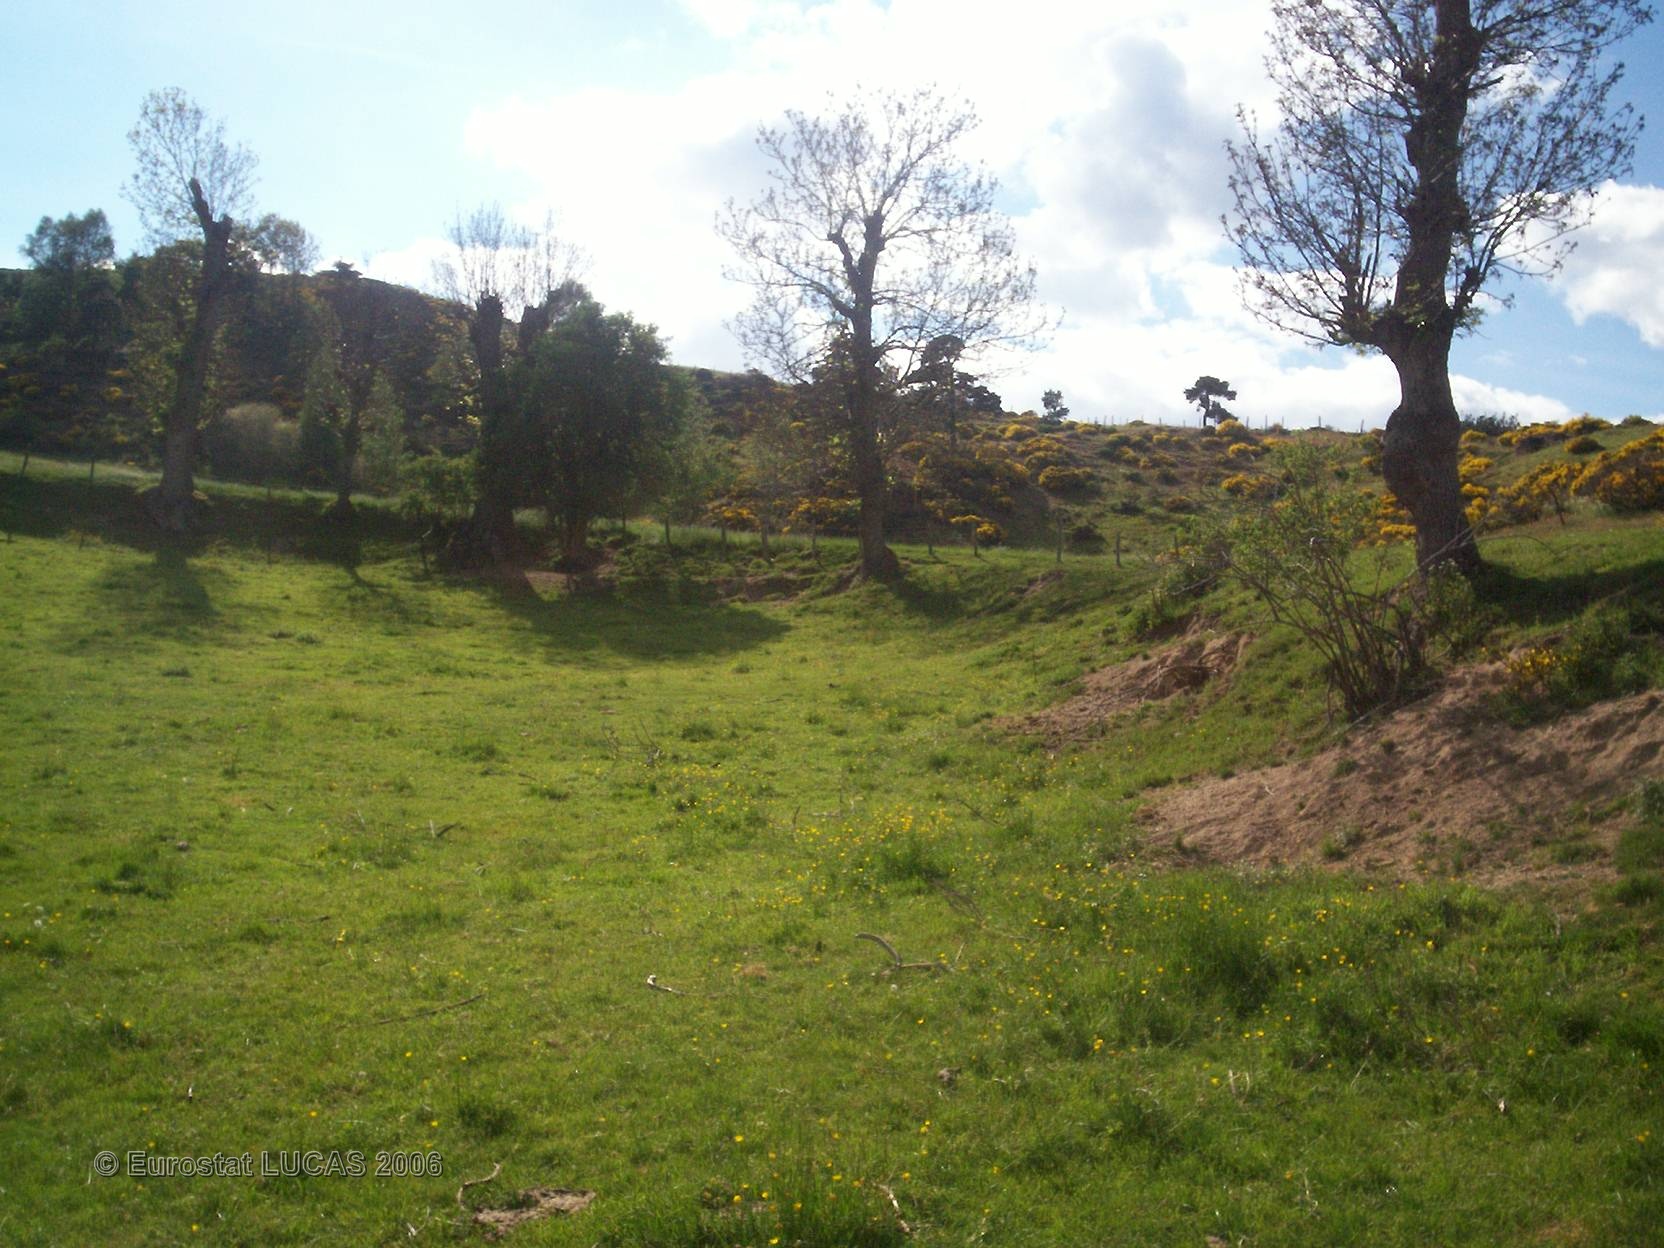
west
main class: Grassland
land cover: Grassland with sparse tree/shrub cover
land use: Agriculture (excluding fallow land and kitchen gardens)
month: May
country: FR
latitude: 44.7177
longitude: 3.3766
